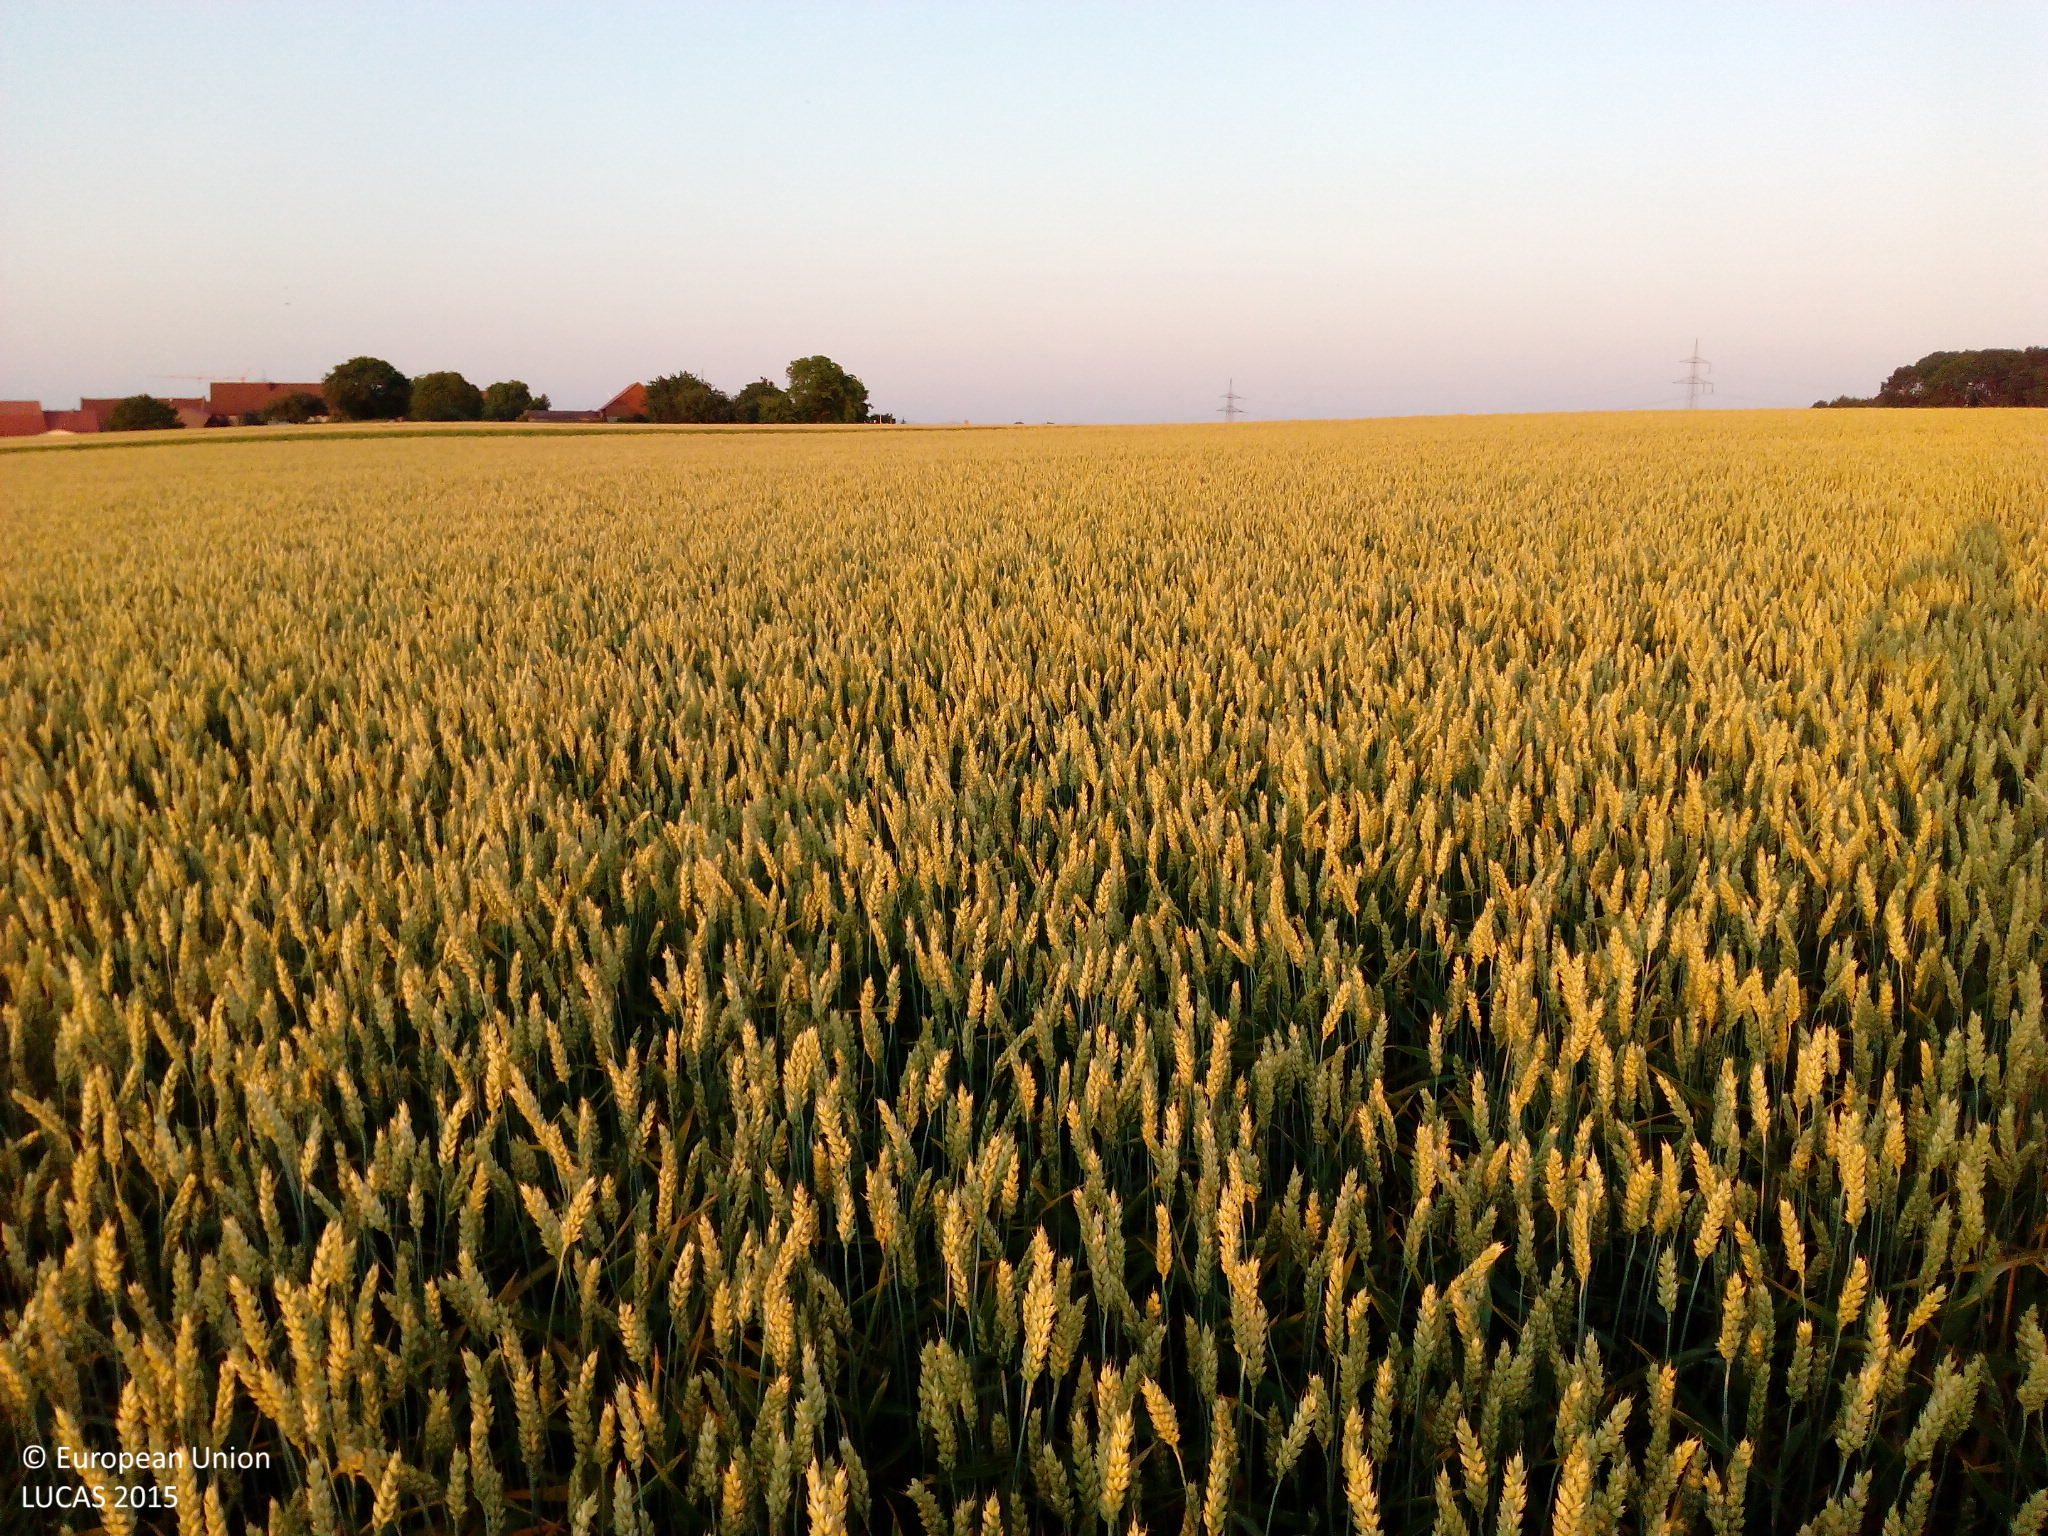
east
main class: Cropland
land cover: Common wheat
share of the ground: > 75 %
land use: Agriculture (excluding fallow land and kitchen gardens)
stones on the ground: < 10 %
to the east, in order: Common wheat; Sugar beet; Common wheat
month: July
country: DE
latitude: 49.5908
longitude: 9.9585
